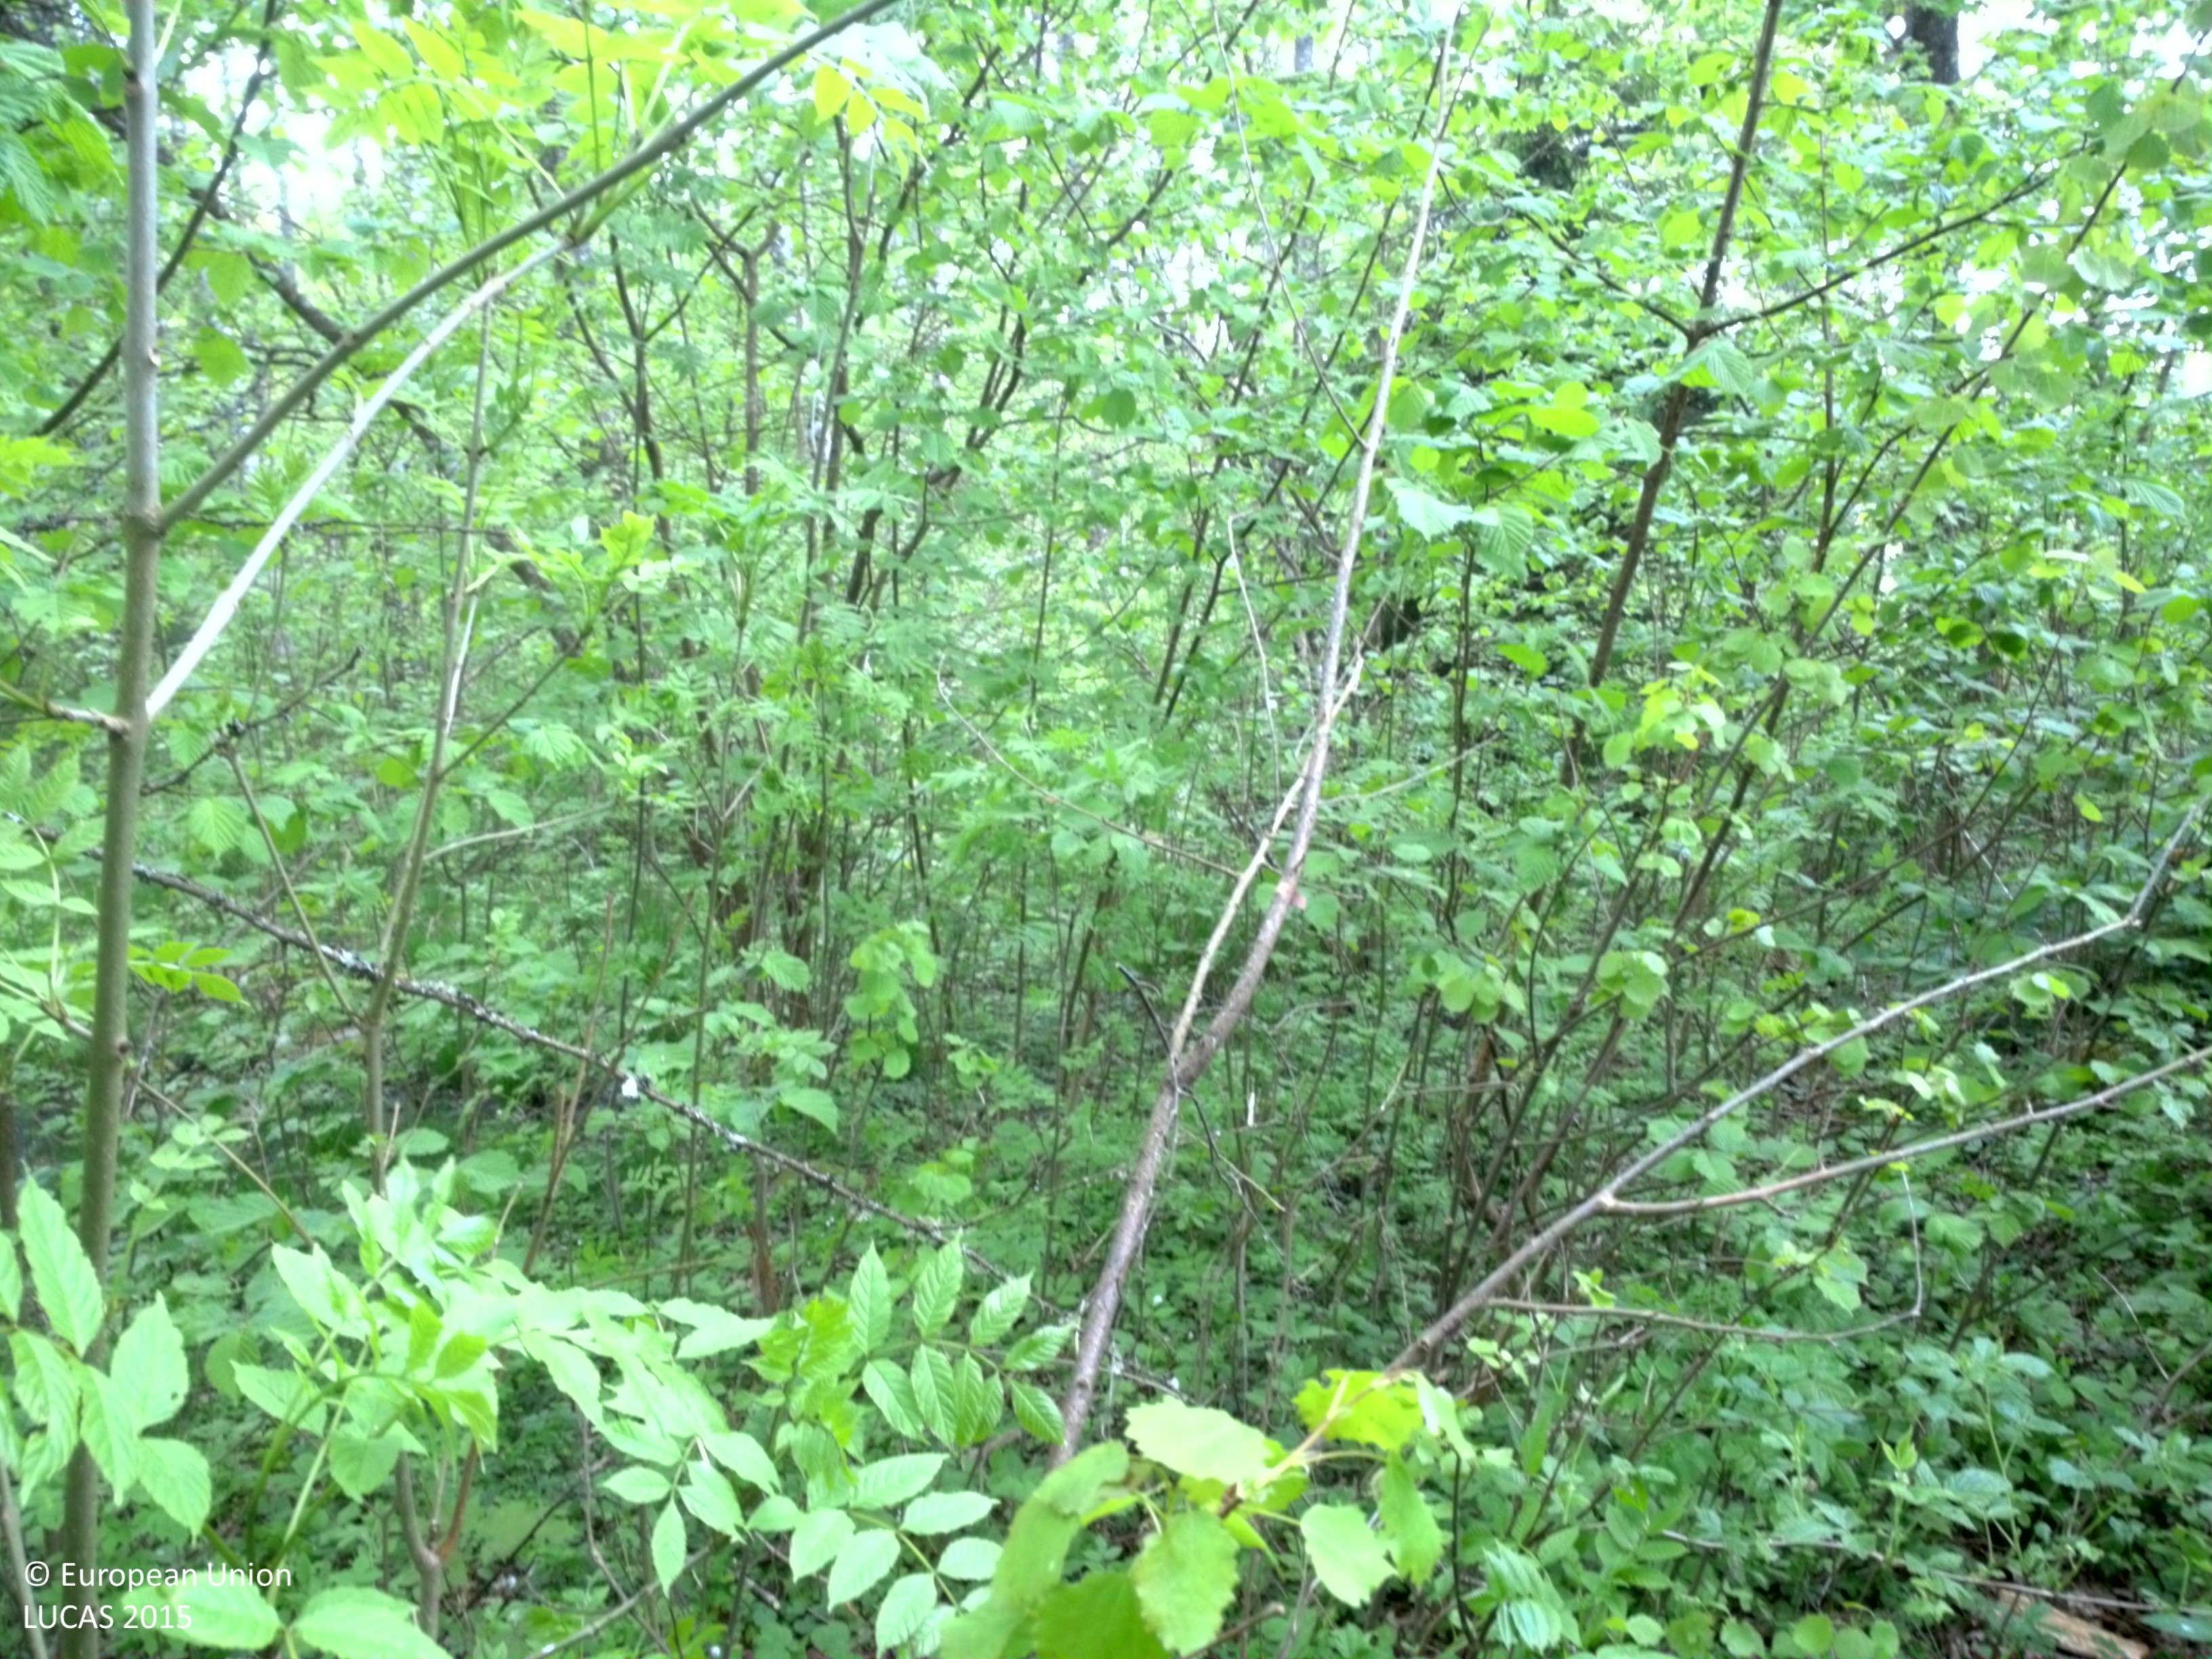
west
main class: Woodland
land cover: Broadleaved woodland
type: mesophytic deciduous forest
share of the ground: > 75 %
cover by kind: broadleaved forest trees 90 %, shrubs 5 %, herbaceous plants 5 %
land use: Forestry
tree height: > 5 m
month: May
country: SE
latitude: 56.5207
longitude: 15.0532
